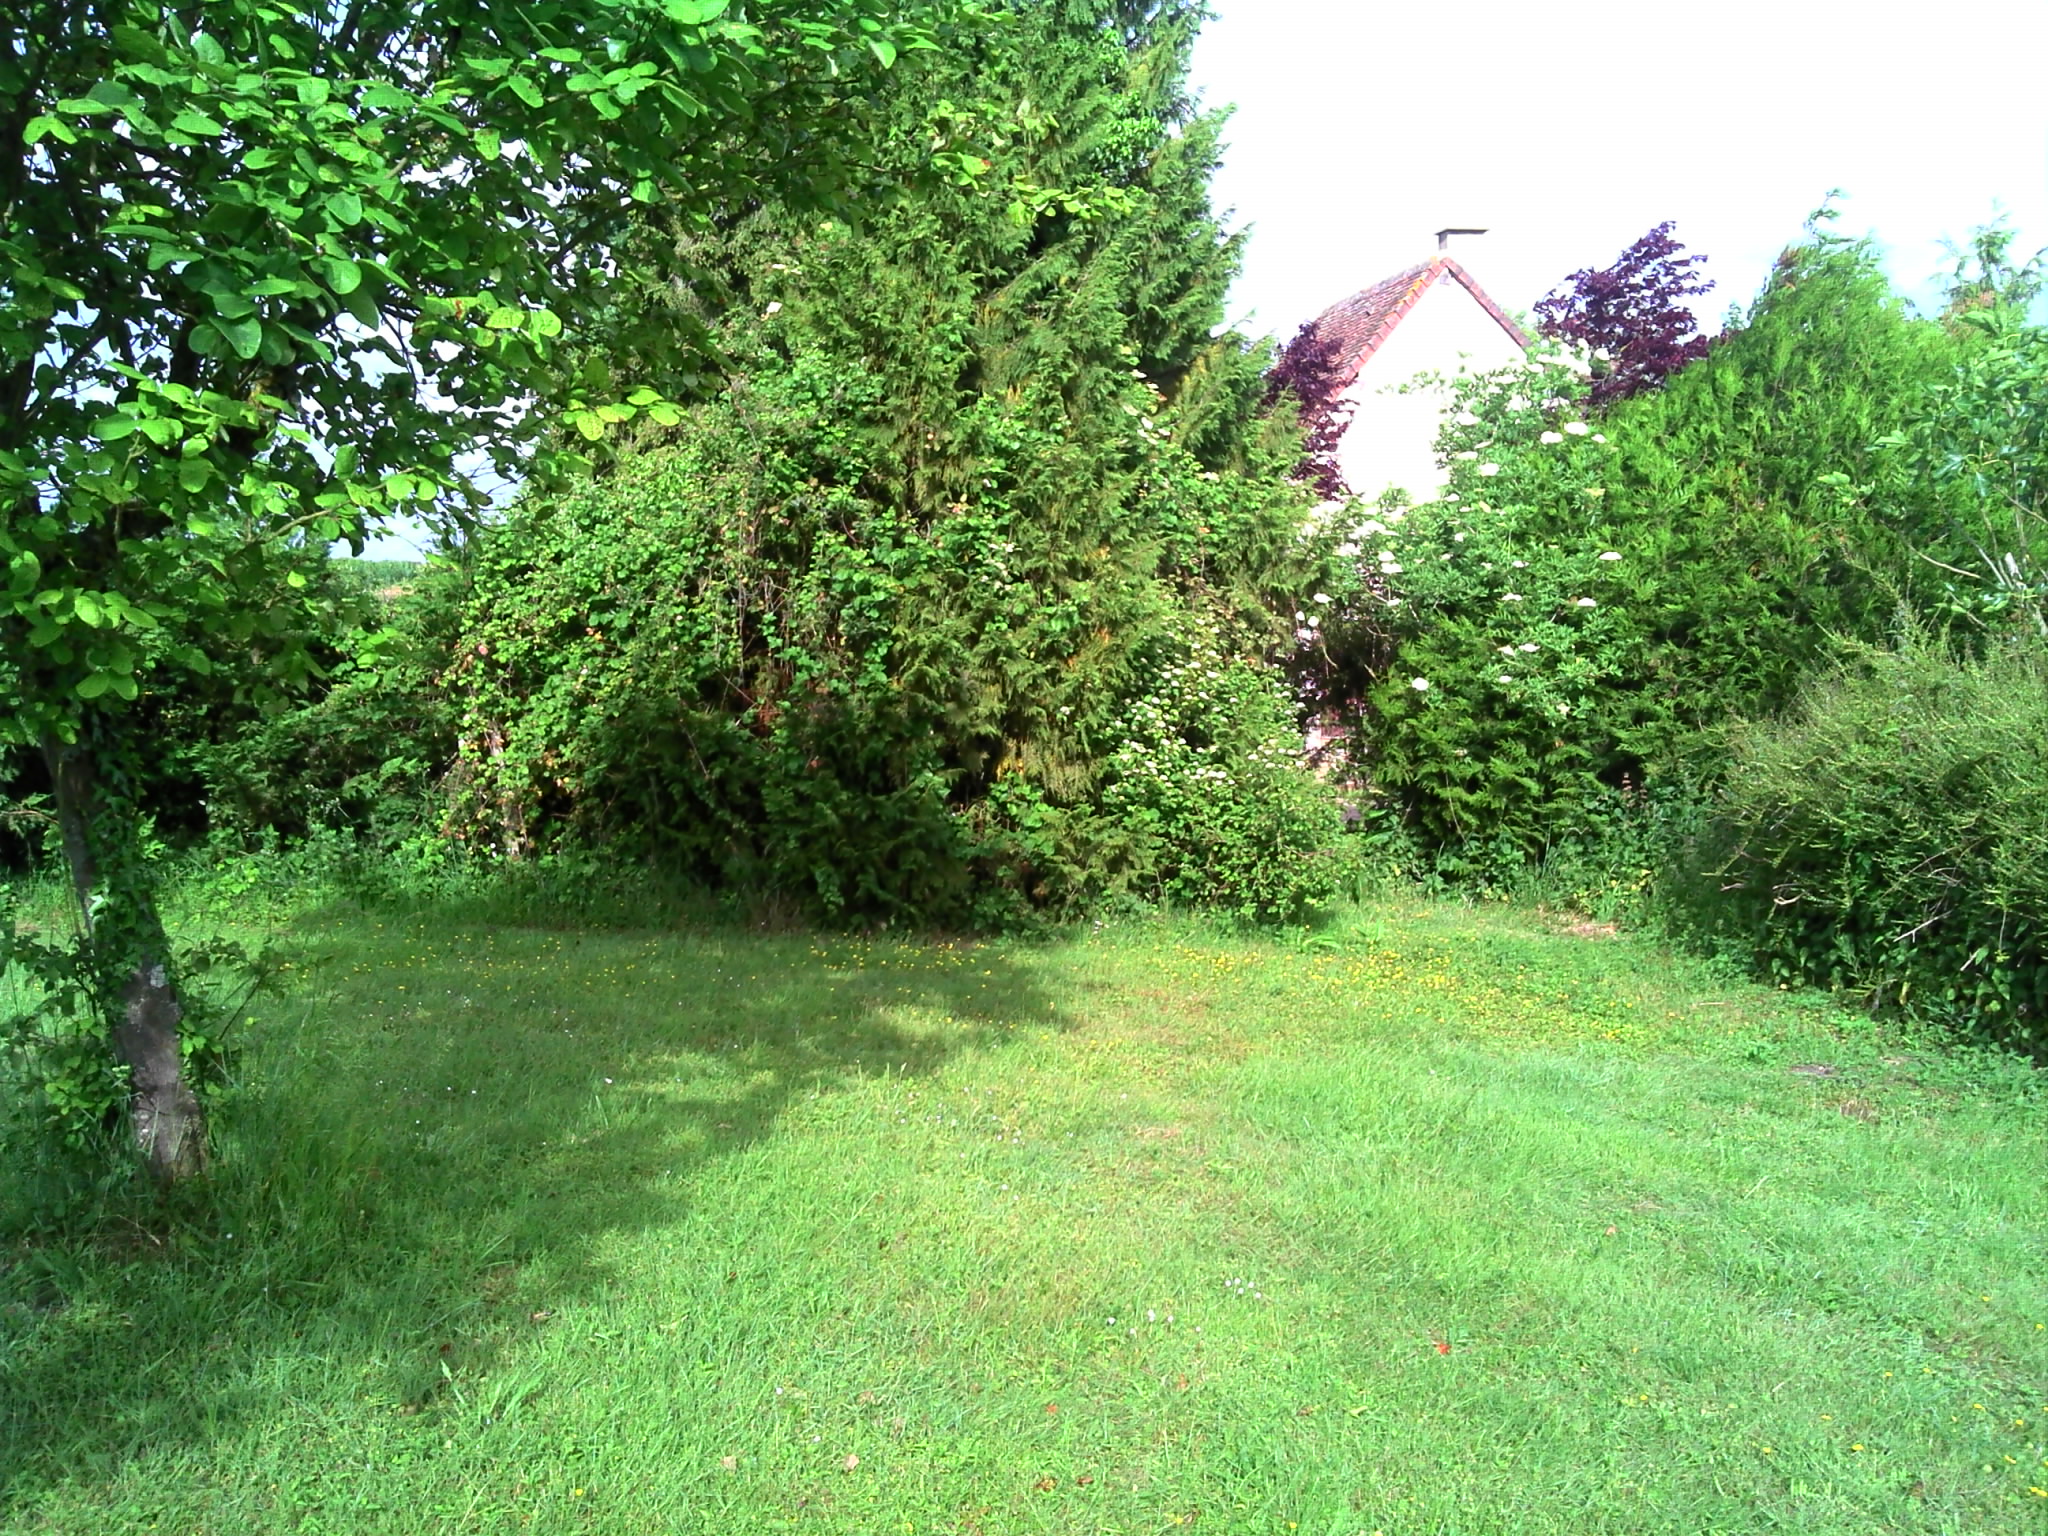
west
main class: Grassland
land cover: Grassland with sparse tree/shrub cover
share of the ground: > 75 %
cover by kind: herbaceous plants 90 %, broadleaved forest trees 5 %, shrubs 5 %
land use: Residential
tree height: < 5 m
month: June
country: FR
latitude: 47.9730
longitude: 1.3433
